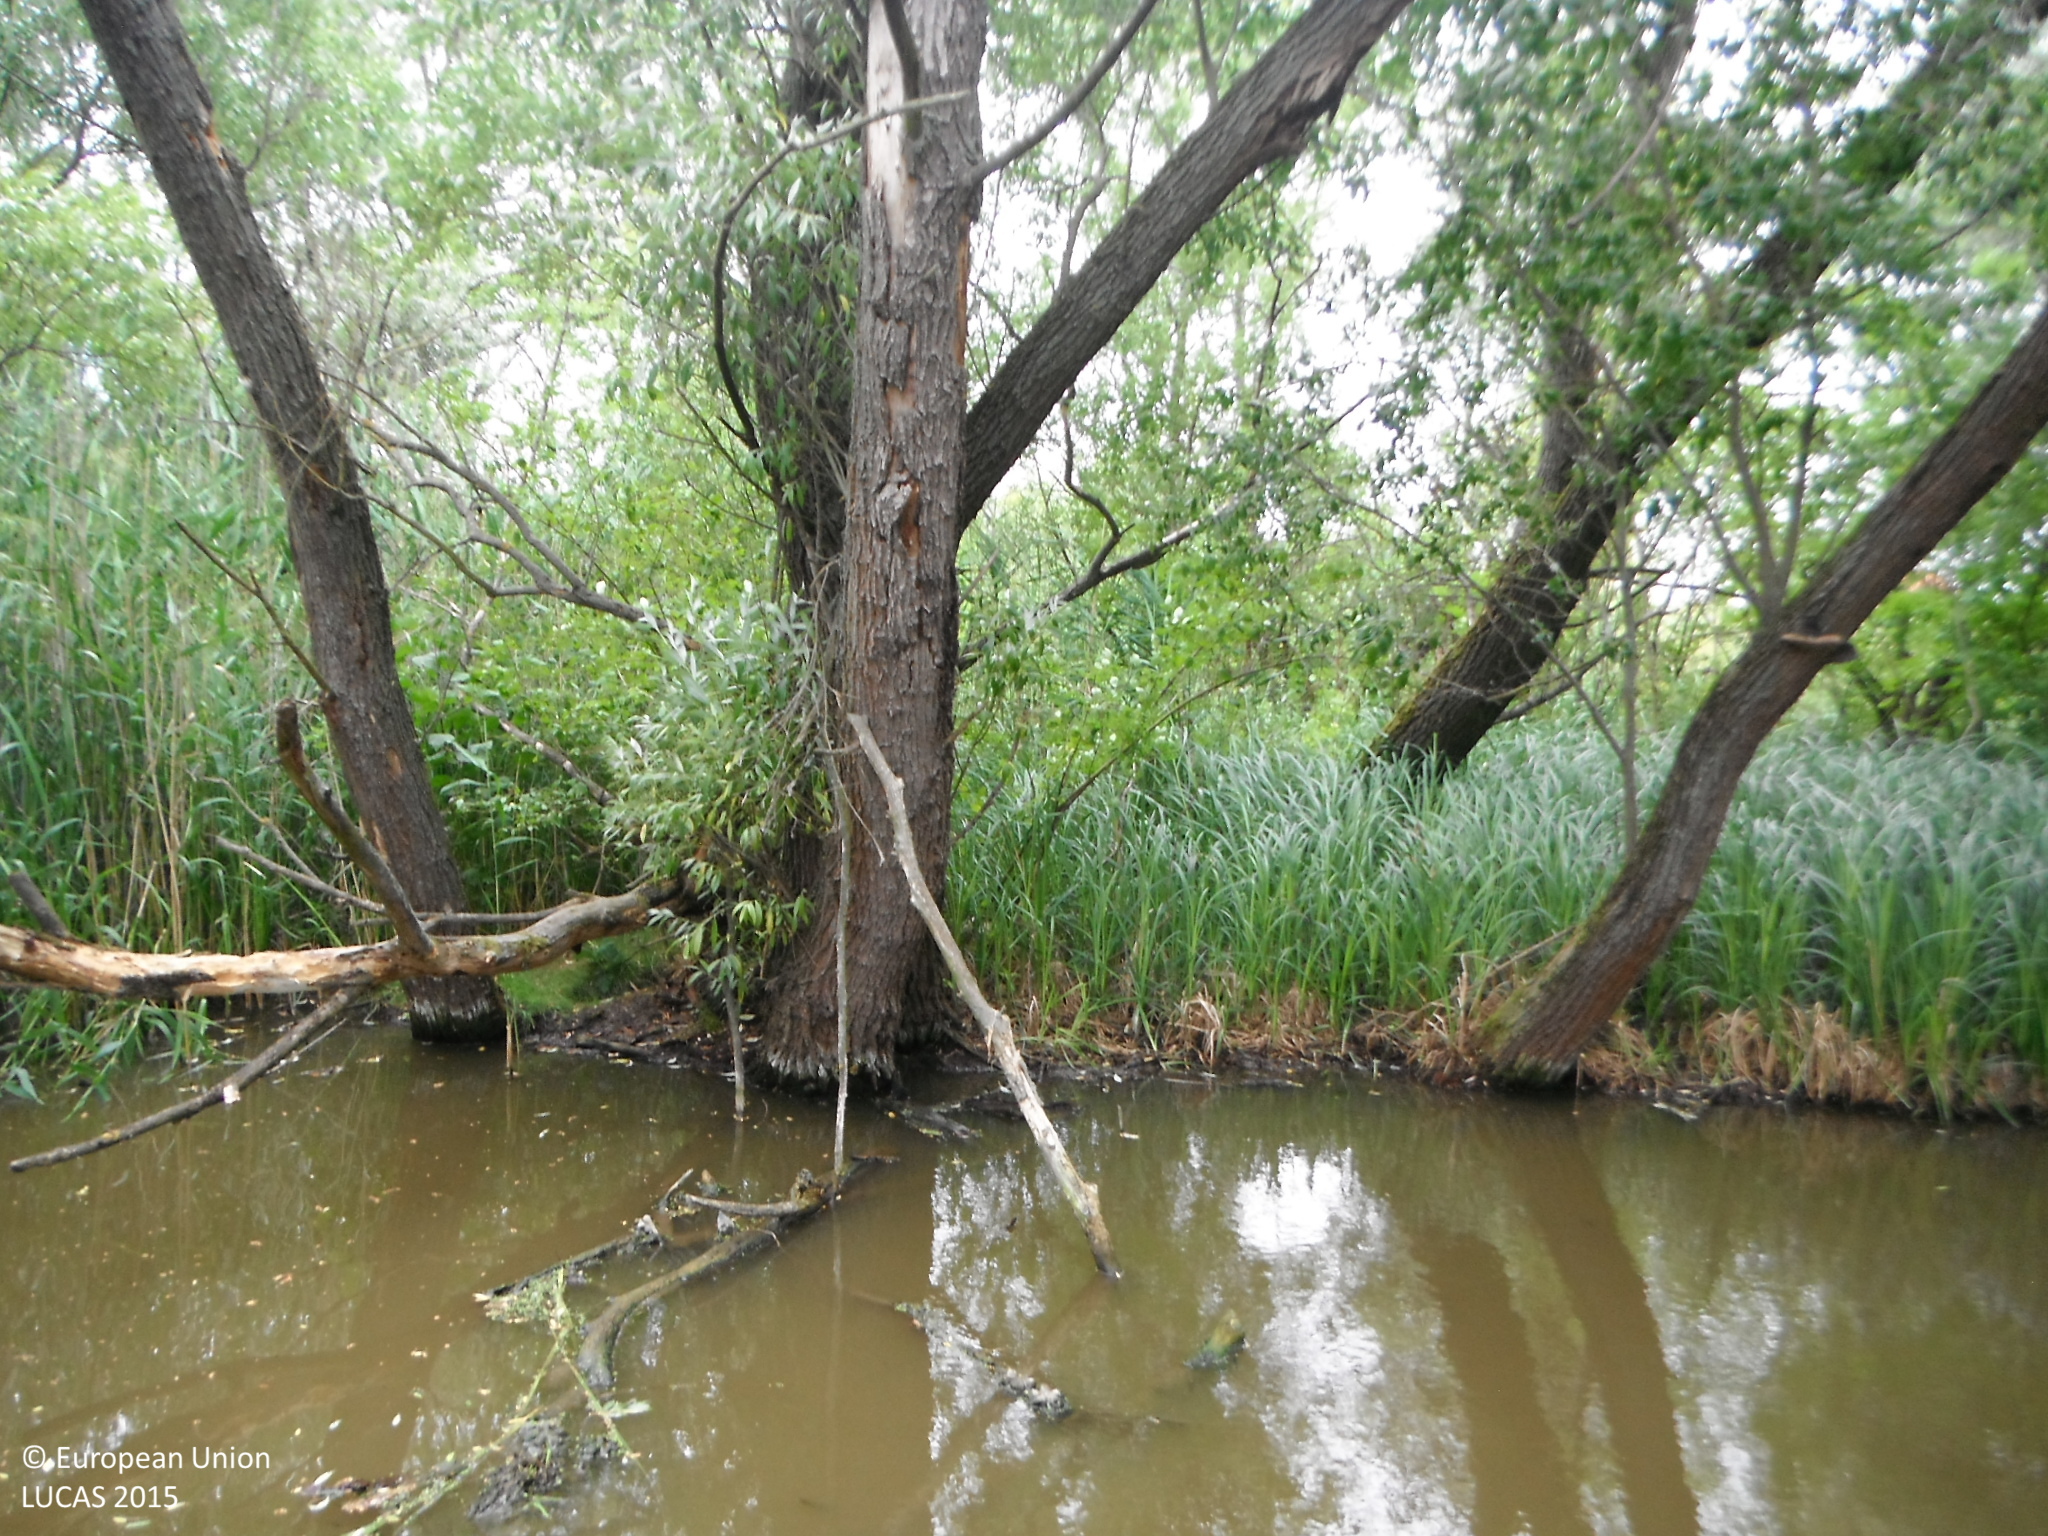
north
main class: Woodland
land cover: Broadleaved woodland
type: mire and swamp forests
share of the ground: > 75 %
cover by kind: broadleaved forest trees 95 %, herbaceous plants 5 %
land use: Semi-natural and natural areas not in use
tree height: > 5 m
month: June
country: SK
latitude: 48.1627
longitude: 18.0666
